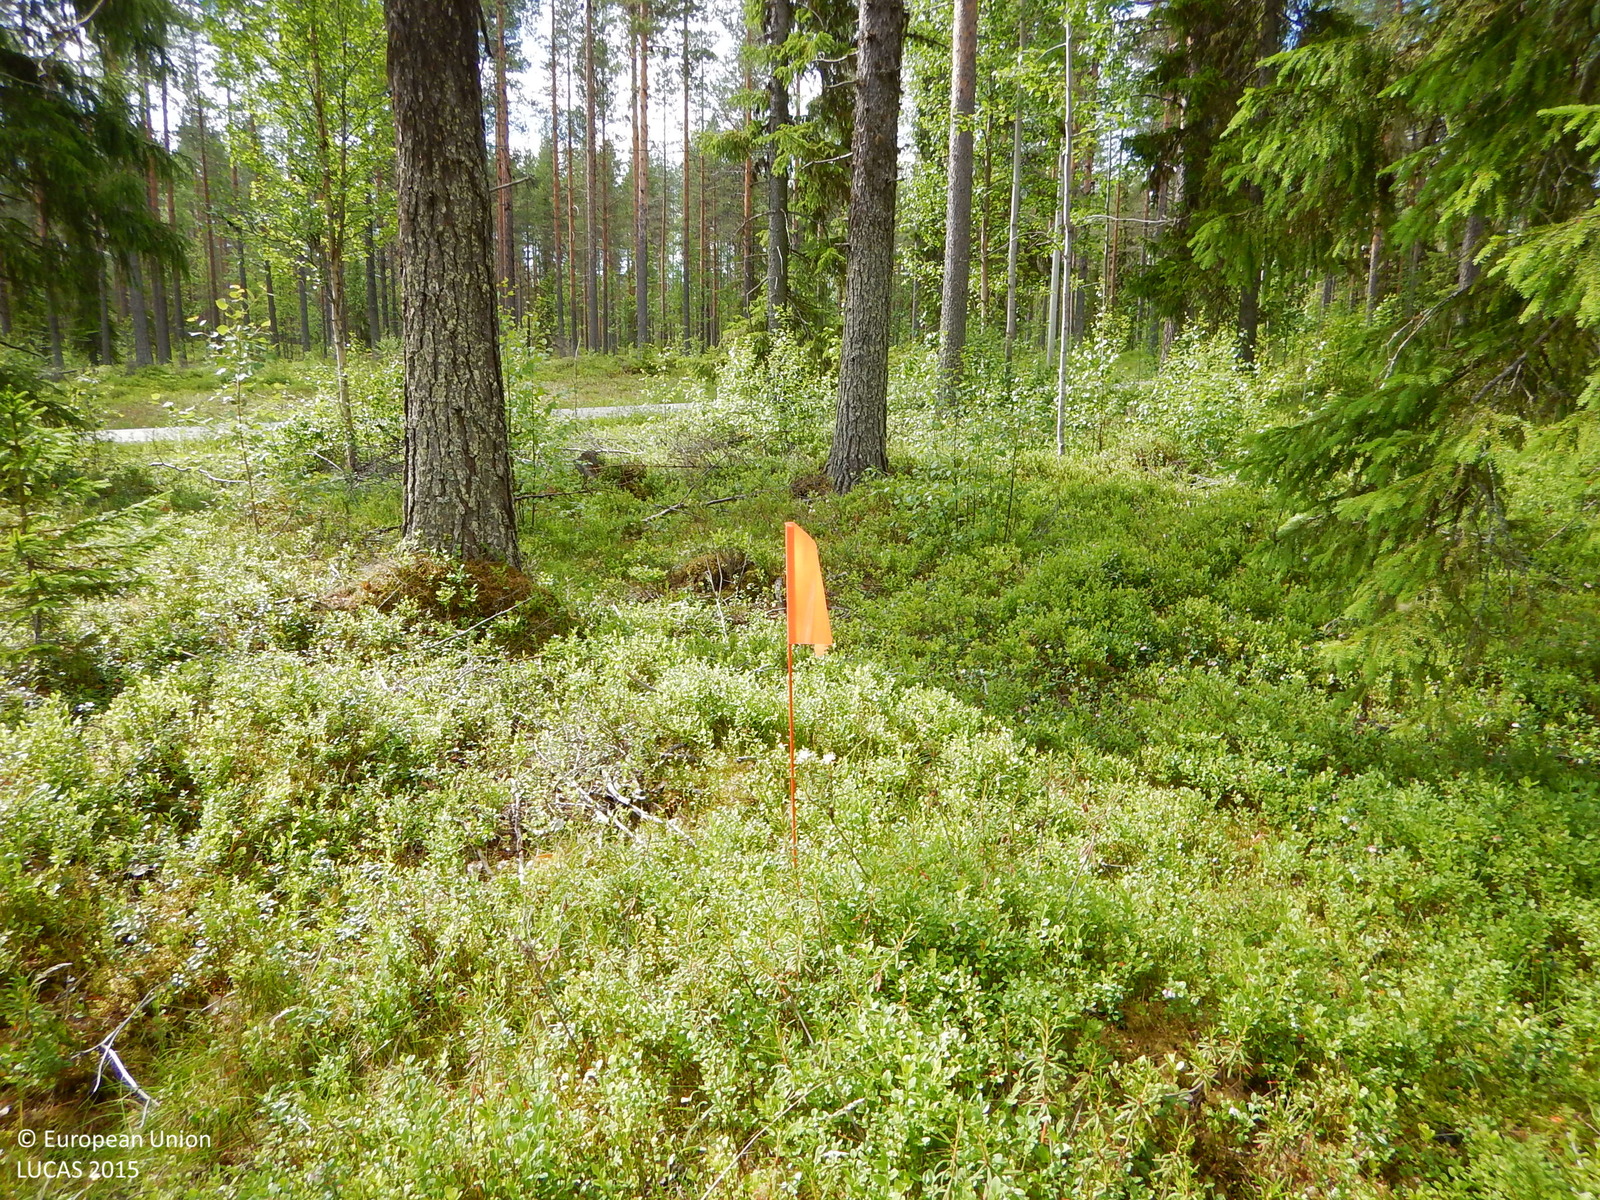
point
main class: Woodland
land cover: Other coniferous woodland
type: boreal forest
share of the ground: 50 - 75 %
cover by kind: coniferous forest trees 45 %, shrubs 20 %, lichens and mosses 15 %, broadleaved forest trees 10 %, herbaceous plants 10 %
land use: Forestry
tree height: > 5 m
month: July
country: SE
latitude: 65.0499
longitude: 19.9757
